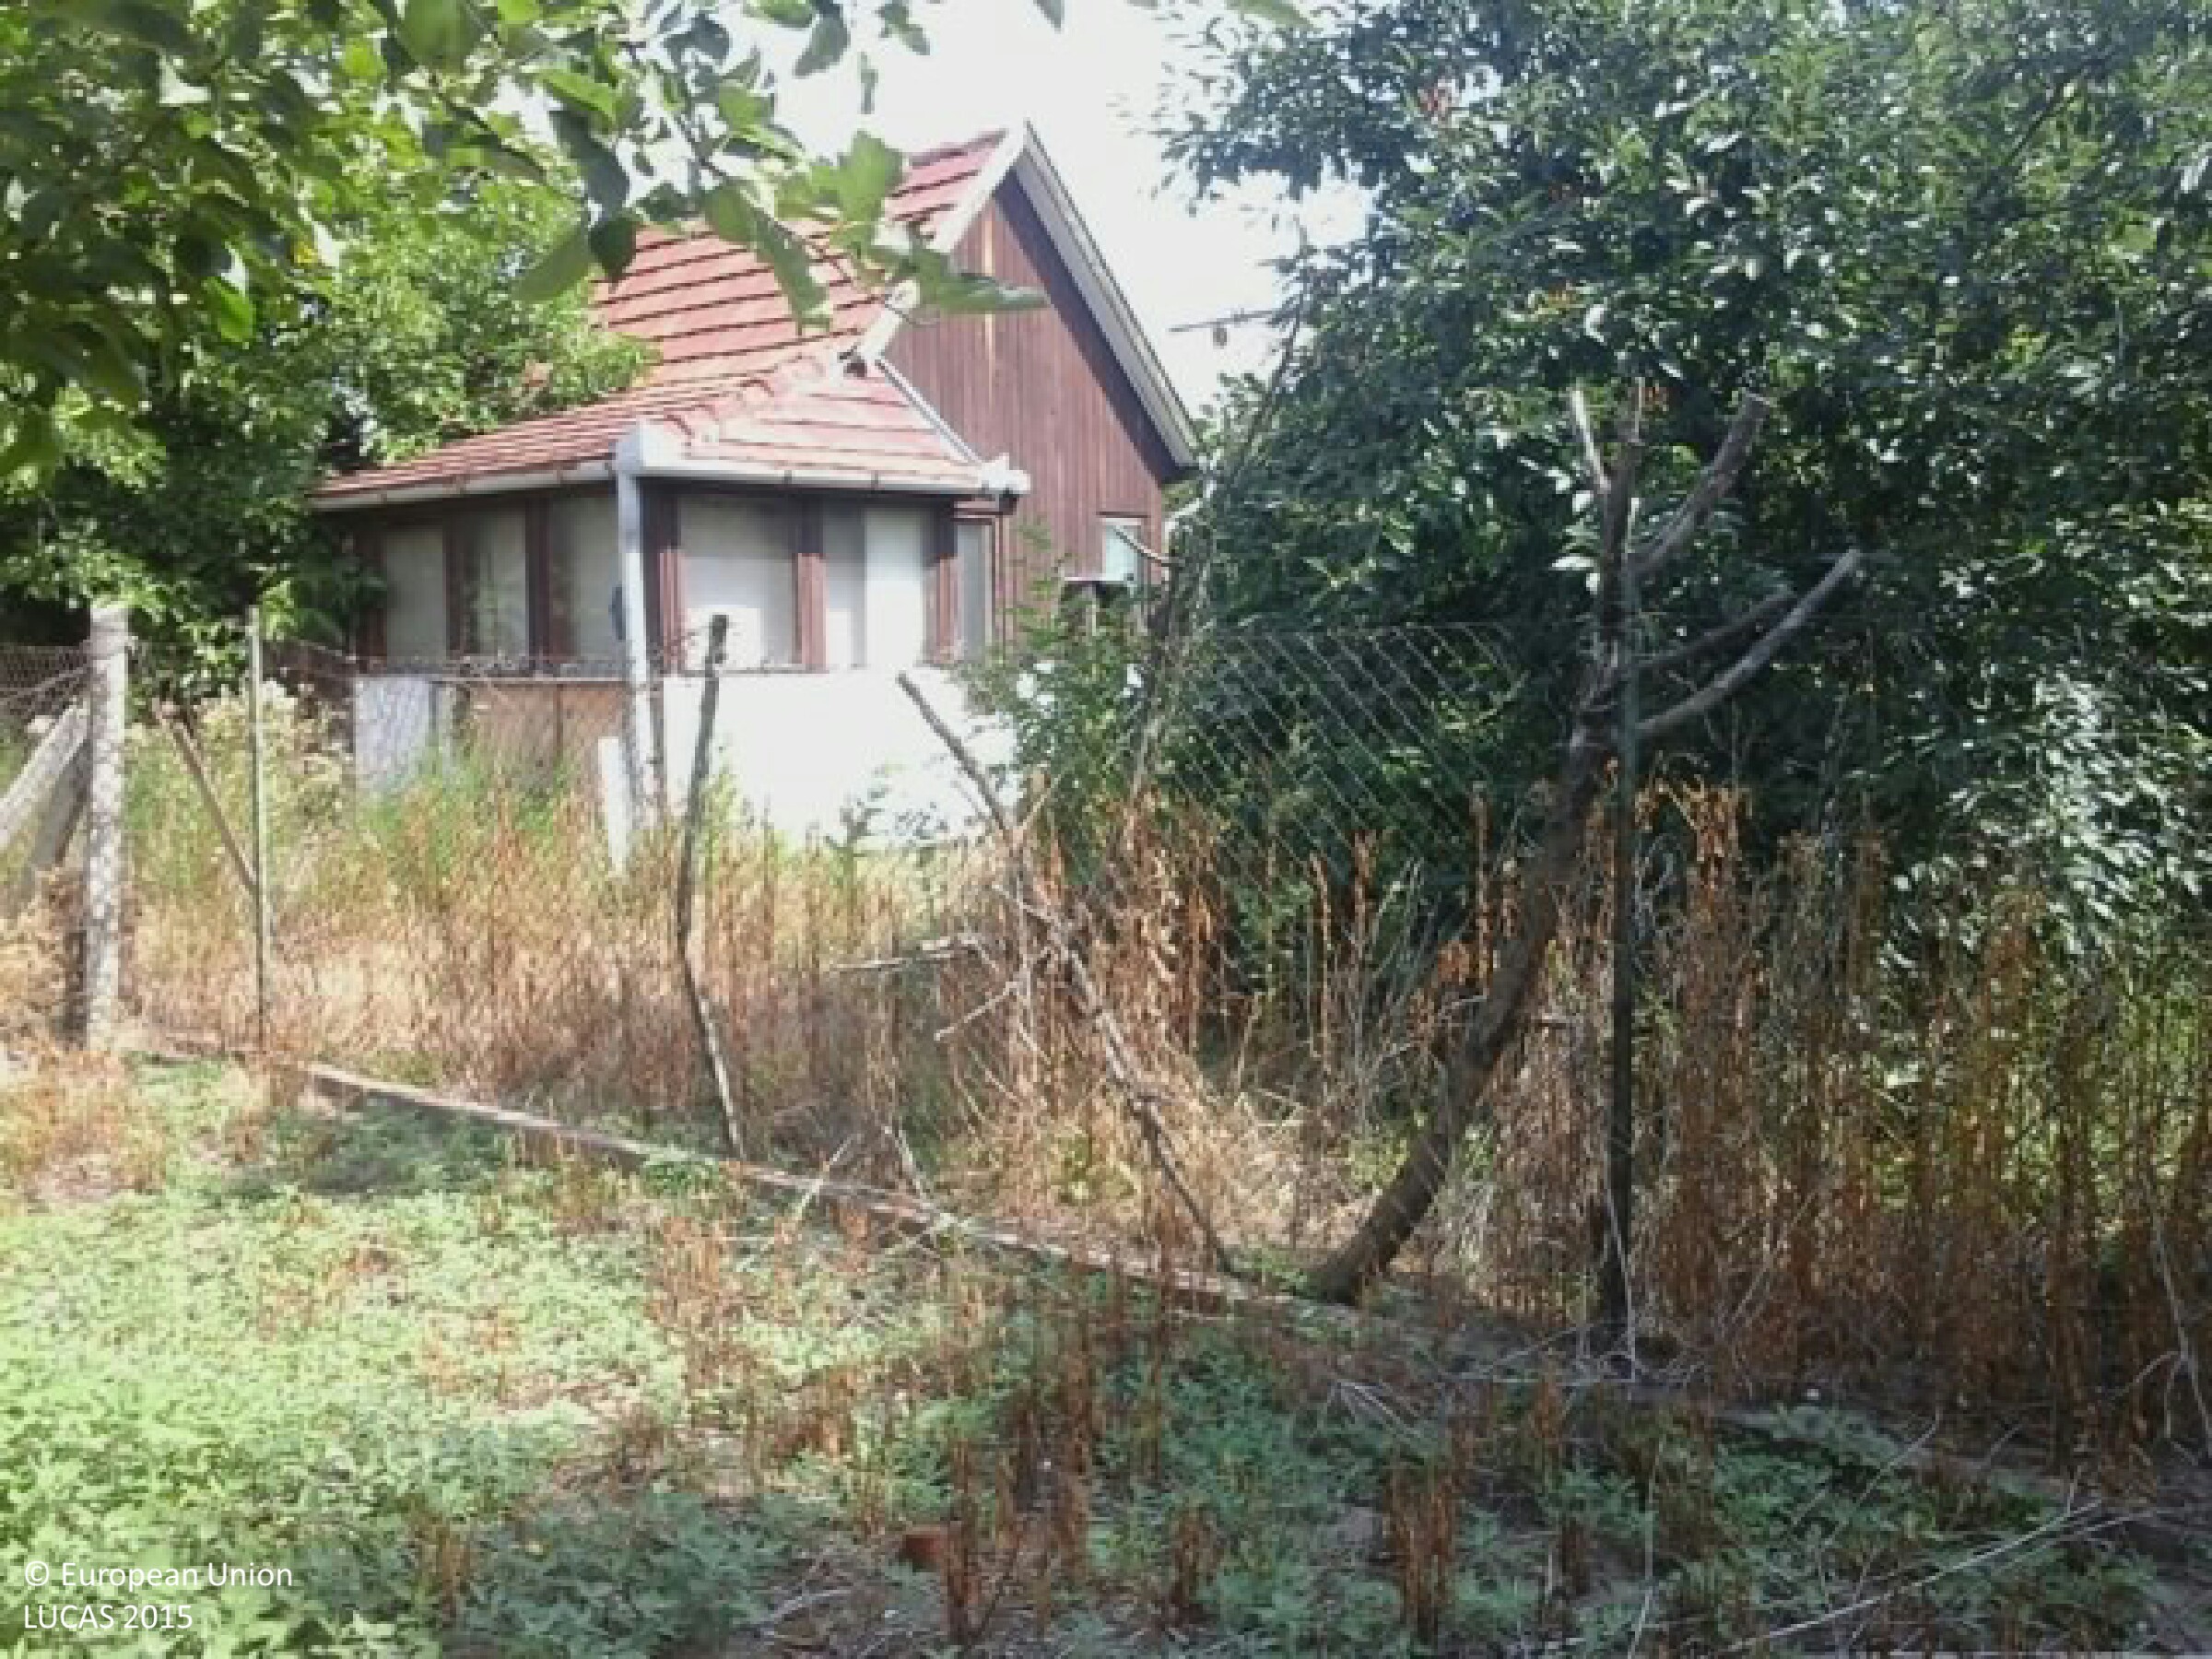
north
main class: Grassland
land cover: Grassland with sparse tree/shrub cover
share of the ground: > 75 %
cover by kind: herbaceous plants 95 %, broadleaved forest trees 5 %
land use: Residential
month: July
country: HU
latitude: 47.3831
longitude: 19.0111
